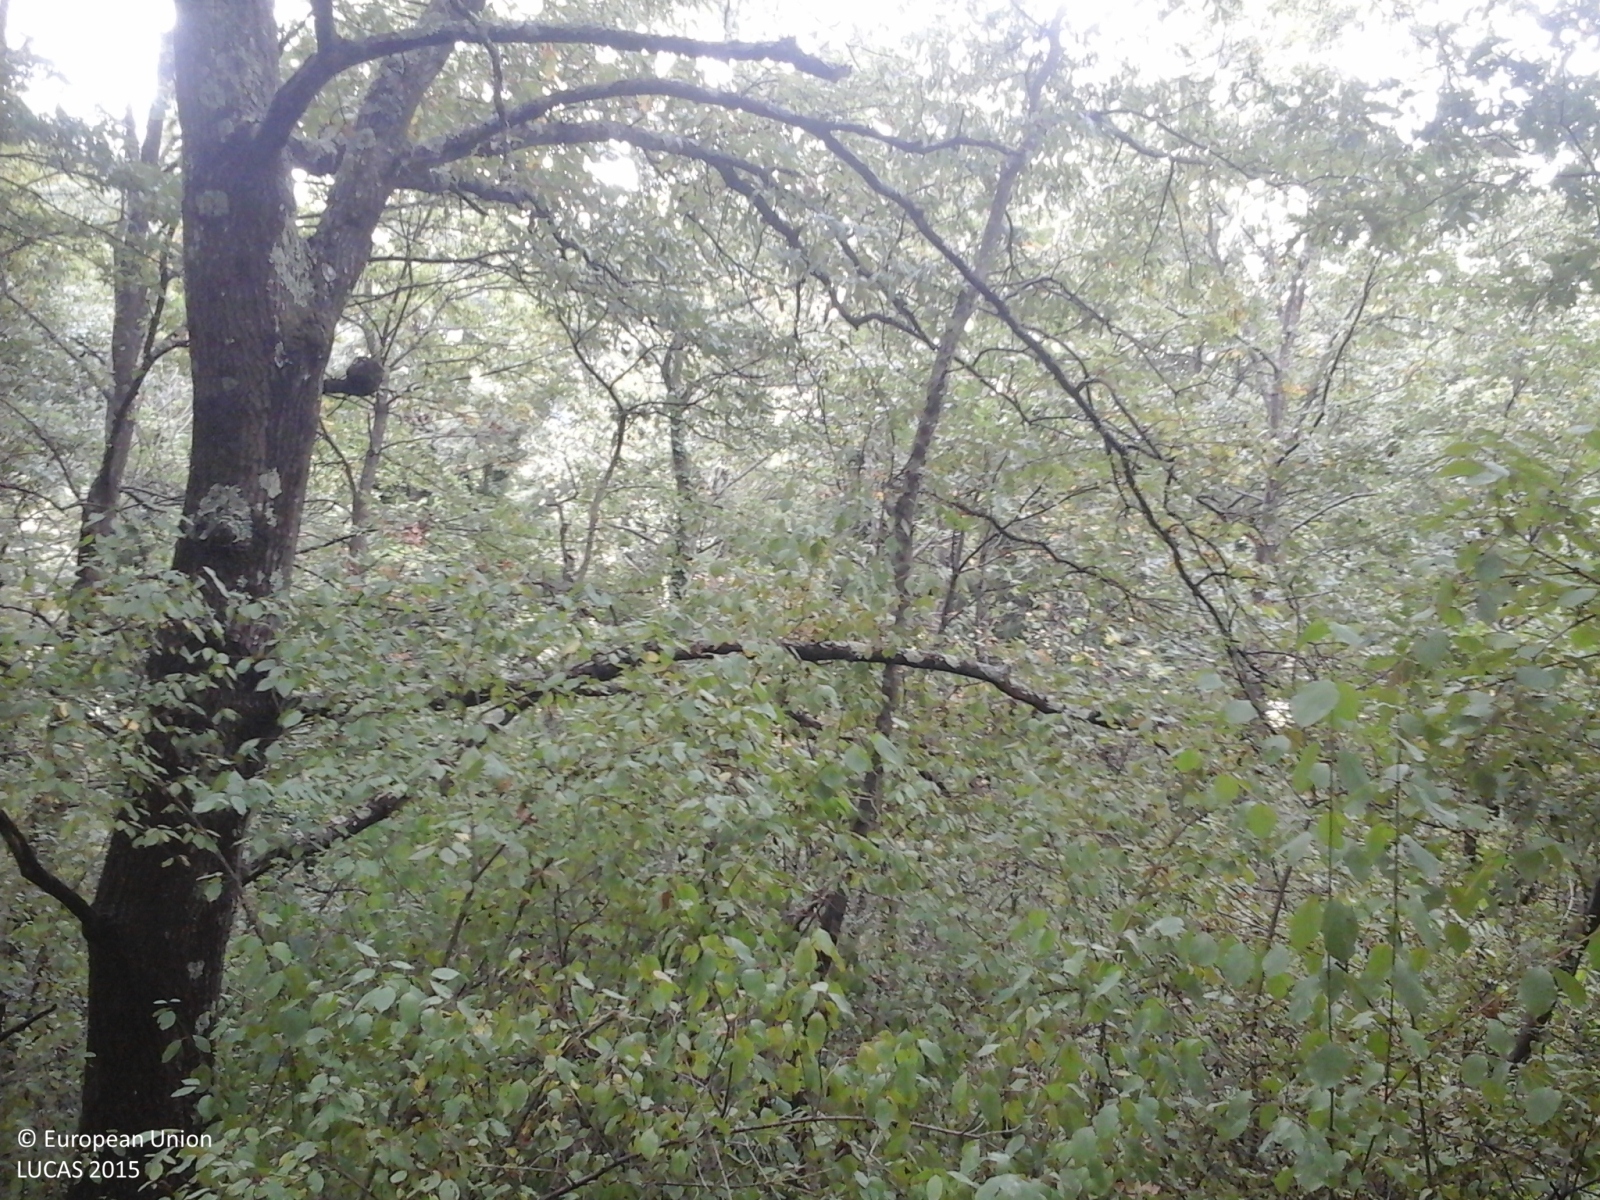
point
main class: Woodland
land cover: Broadleaved woodland
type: thermophilous deciduous forest
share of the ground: > 75 %
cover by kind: broadleaved forest trees 80 %, shrubs 15 %, herbaceous plants 5 %
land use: Forestry
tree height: > 5 m
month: October
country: IT
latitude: 43.2904
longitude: 12.5443
